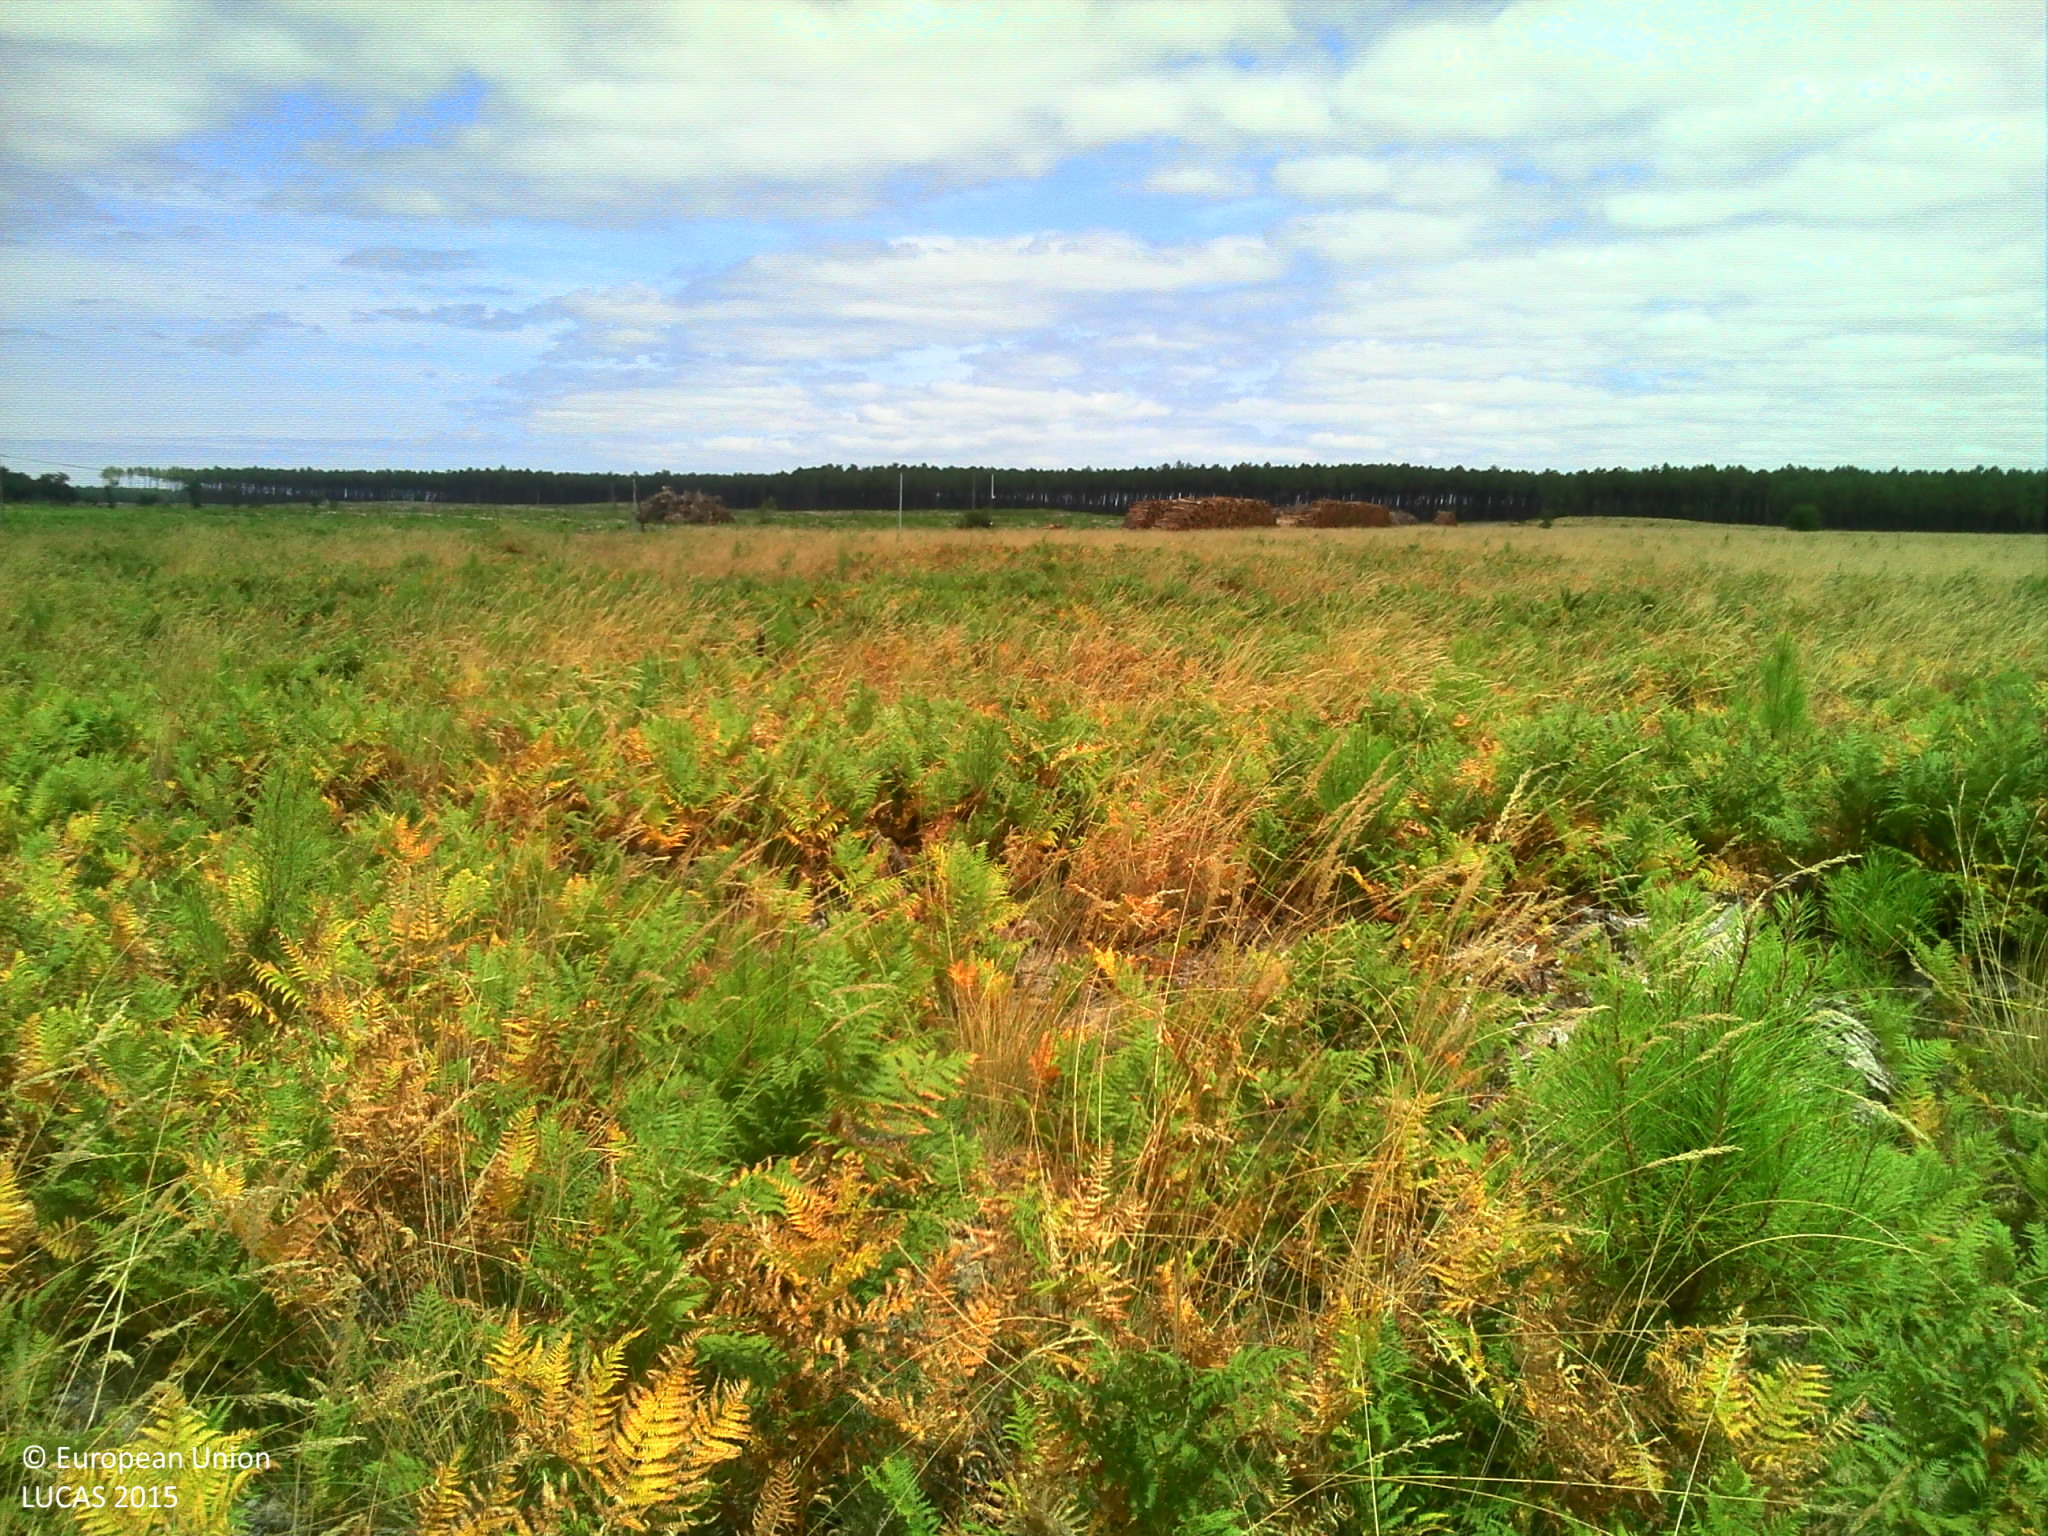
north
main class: Grassland
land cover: Grassland with sparse tree/shrub cover
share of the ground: > 75 %
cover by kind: herbaceous plants 85 %, broadleaved forest trees 5 %, shrubs 5 %, unconsolidated bare surface 5 %
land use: Forestry
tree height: < 5 m
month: July
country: FR
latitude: 43.9581
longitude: -1.2226
